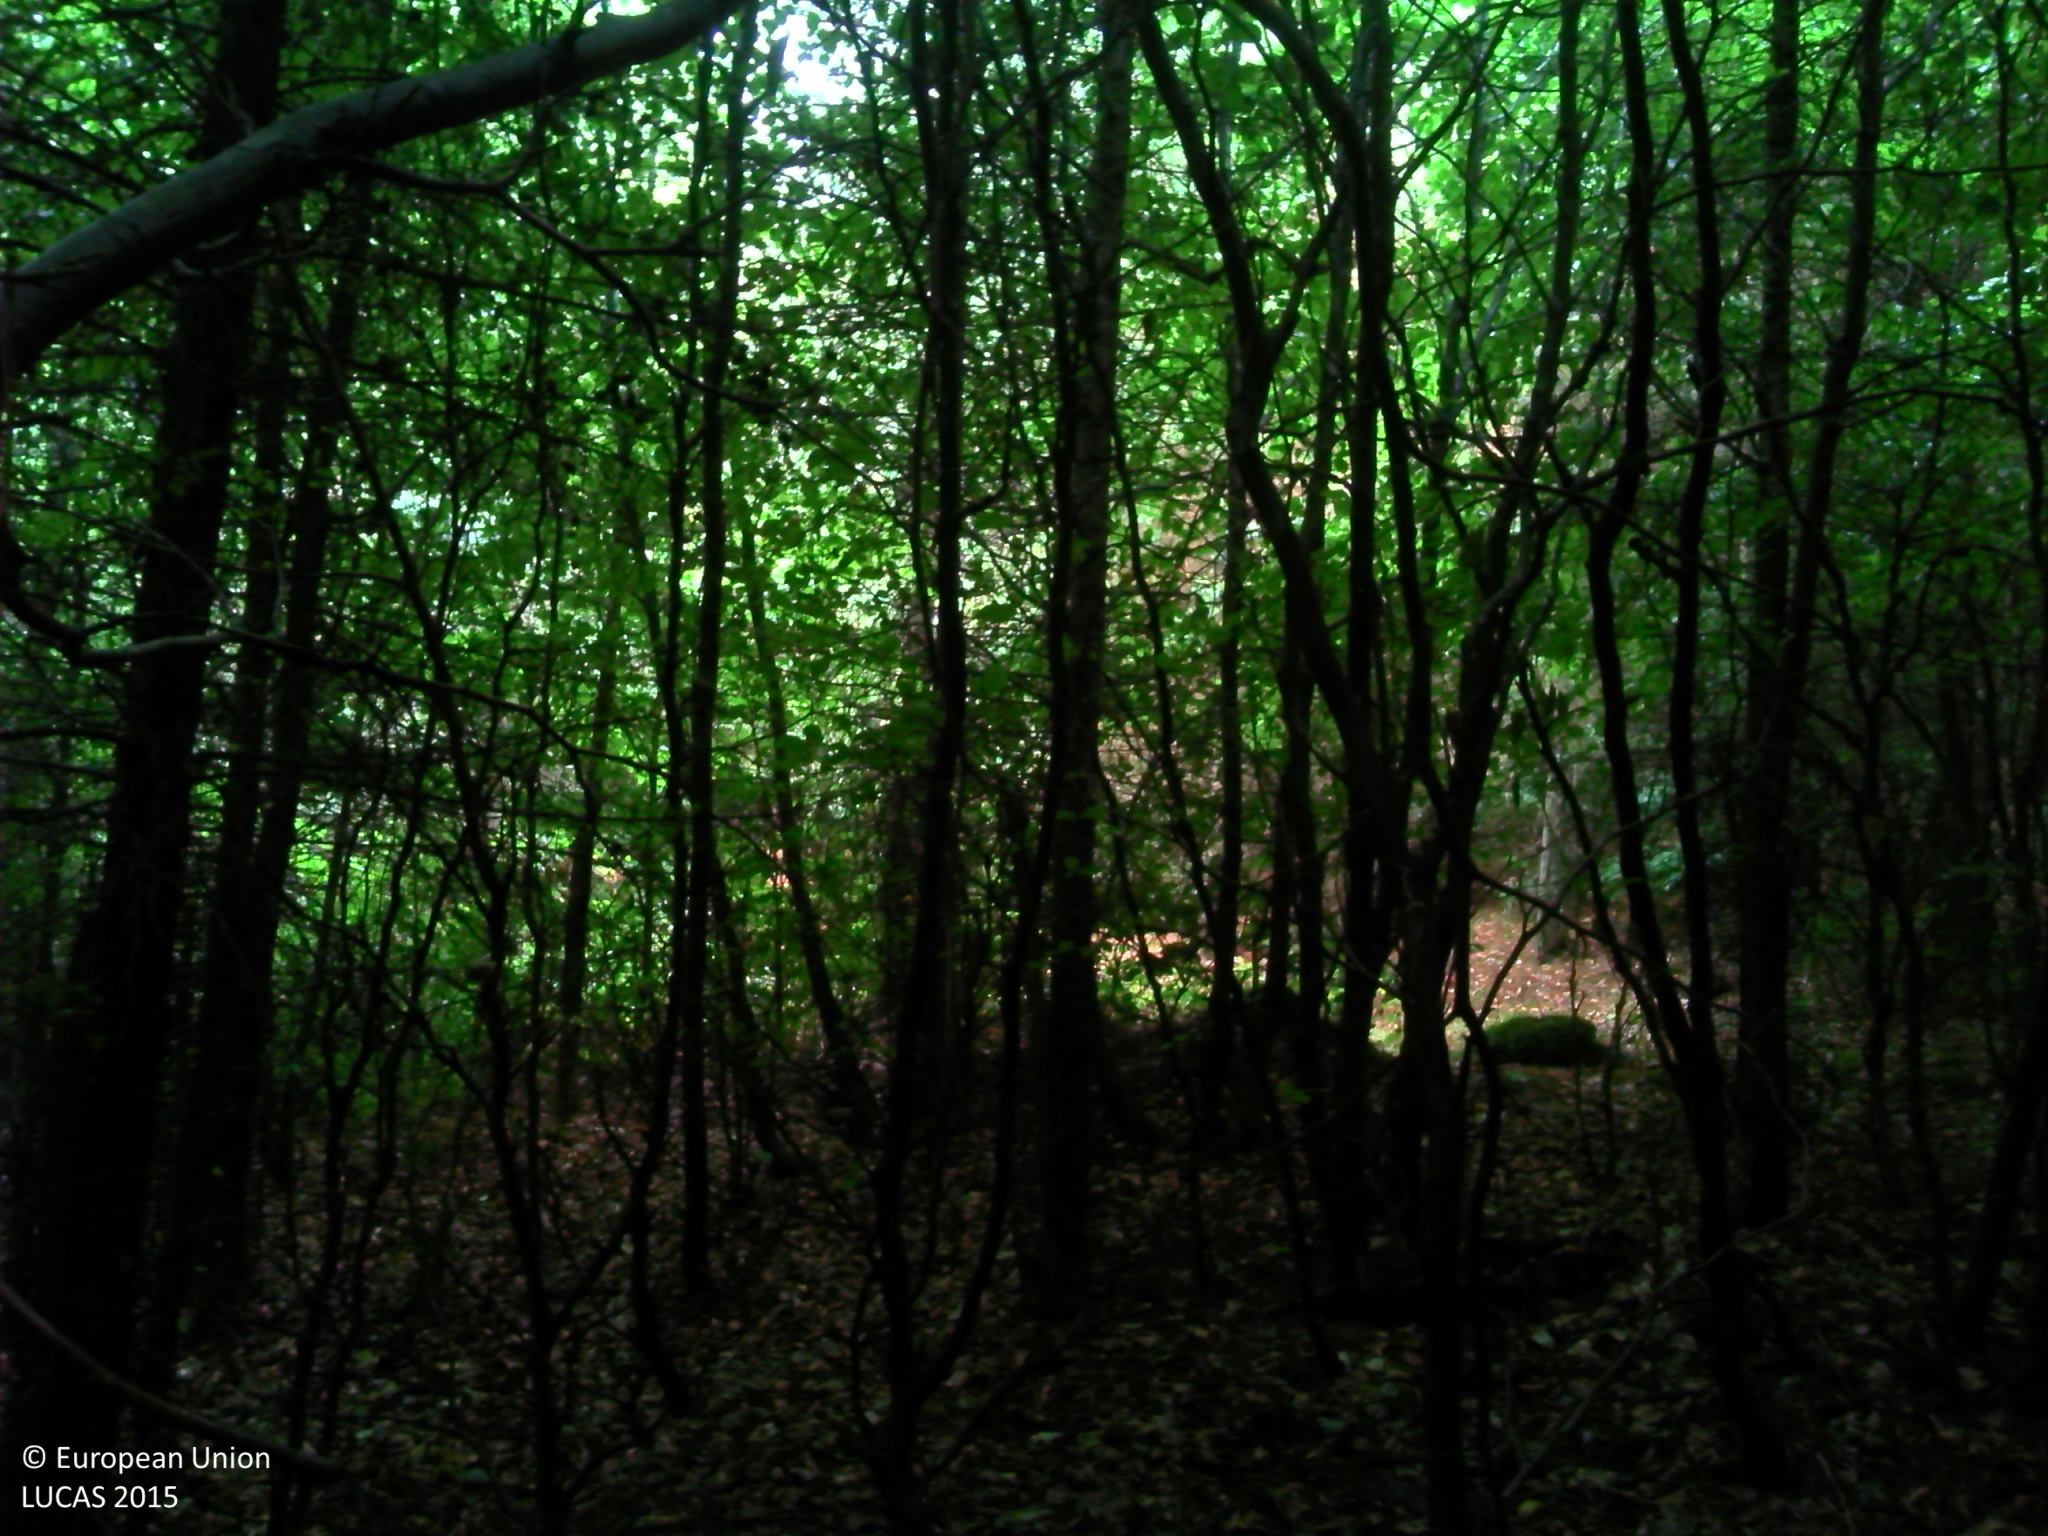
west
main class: Woodland
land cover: Broadleaved woodland
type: beech forest
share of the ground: > 75 %
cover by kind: broadleaved forest trees 100 %
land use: Forestry
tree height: > 5 m
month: July
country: FR
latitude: 48.9711
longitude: 7.5826
